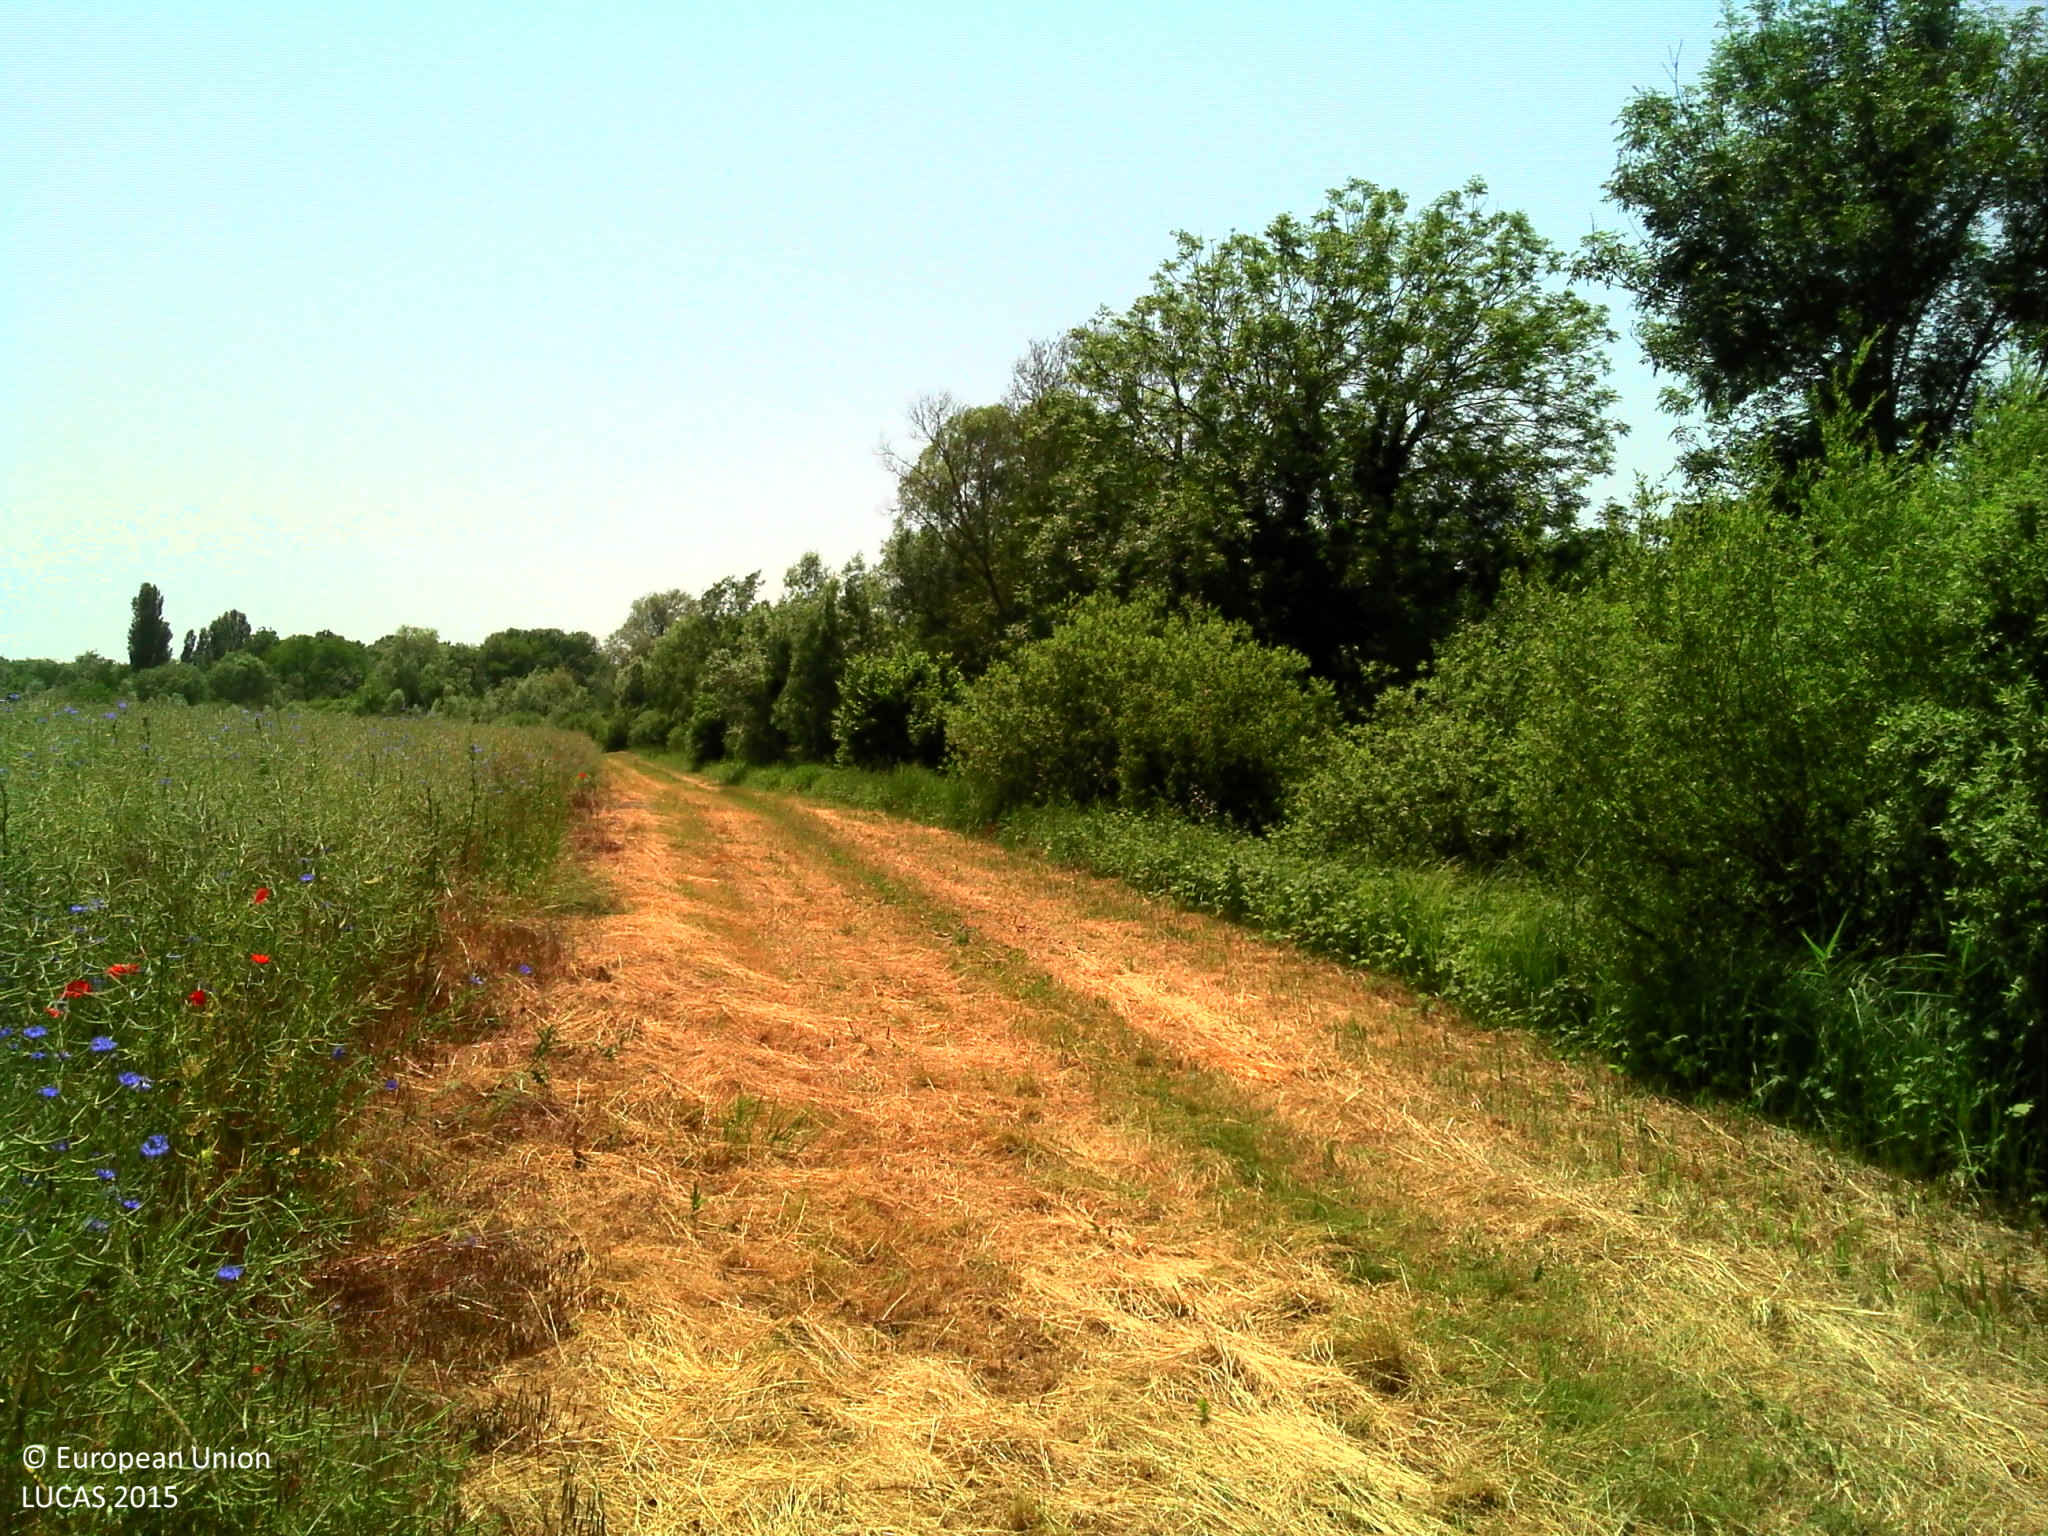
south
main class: Cropland
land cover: Rape and turnip rape
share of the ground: > 75 %
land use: Agriculture (excluding fallow land and kitchen gardens)
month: June
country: FR
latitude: 47.3245
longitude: 5.1713
